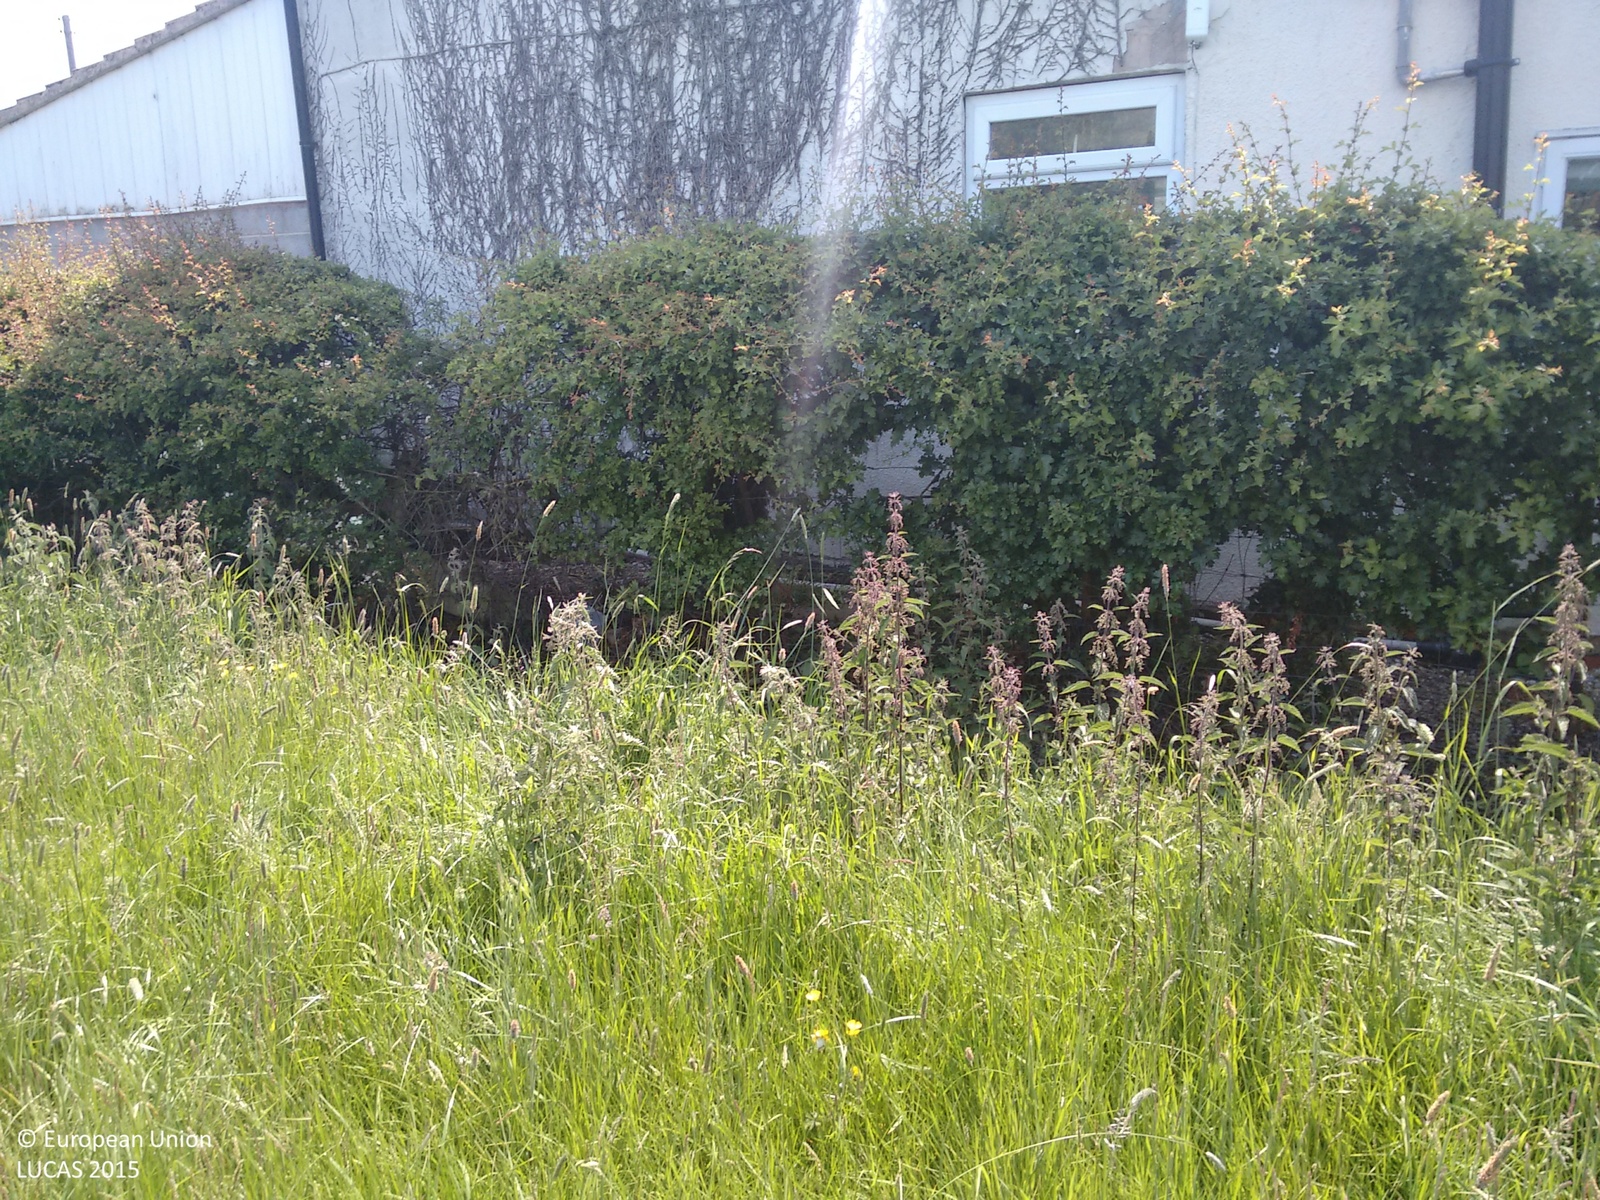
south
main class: Grassland
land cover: Grassland without tree/shrub cover
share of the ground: > 75 %
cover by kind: herbaceous plants 95 %, shrubs 5 %
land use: Agriculture (excluding fallow land and kitchen gardens)
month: June
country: GB
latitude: 53.8088
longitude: -1.1767
